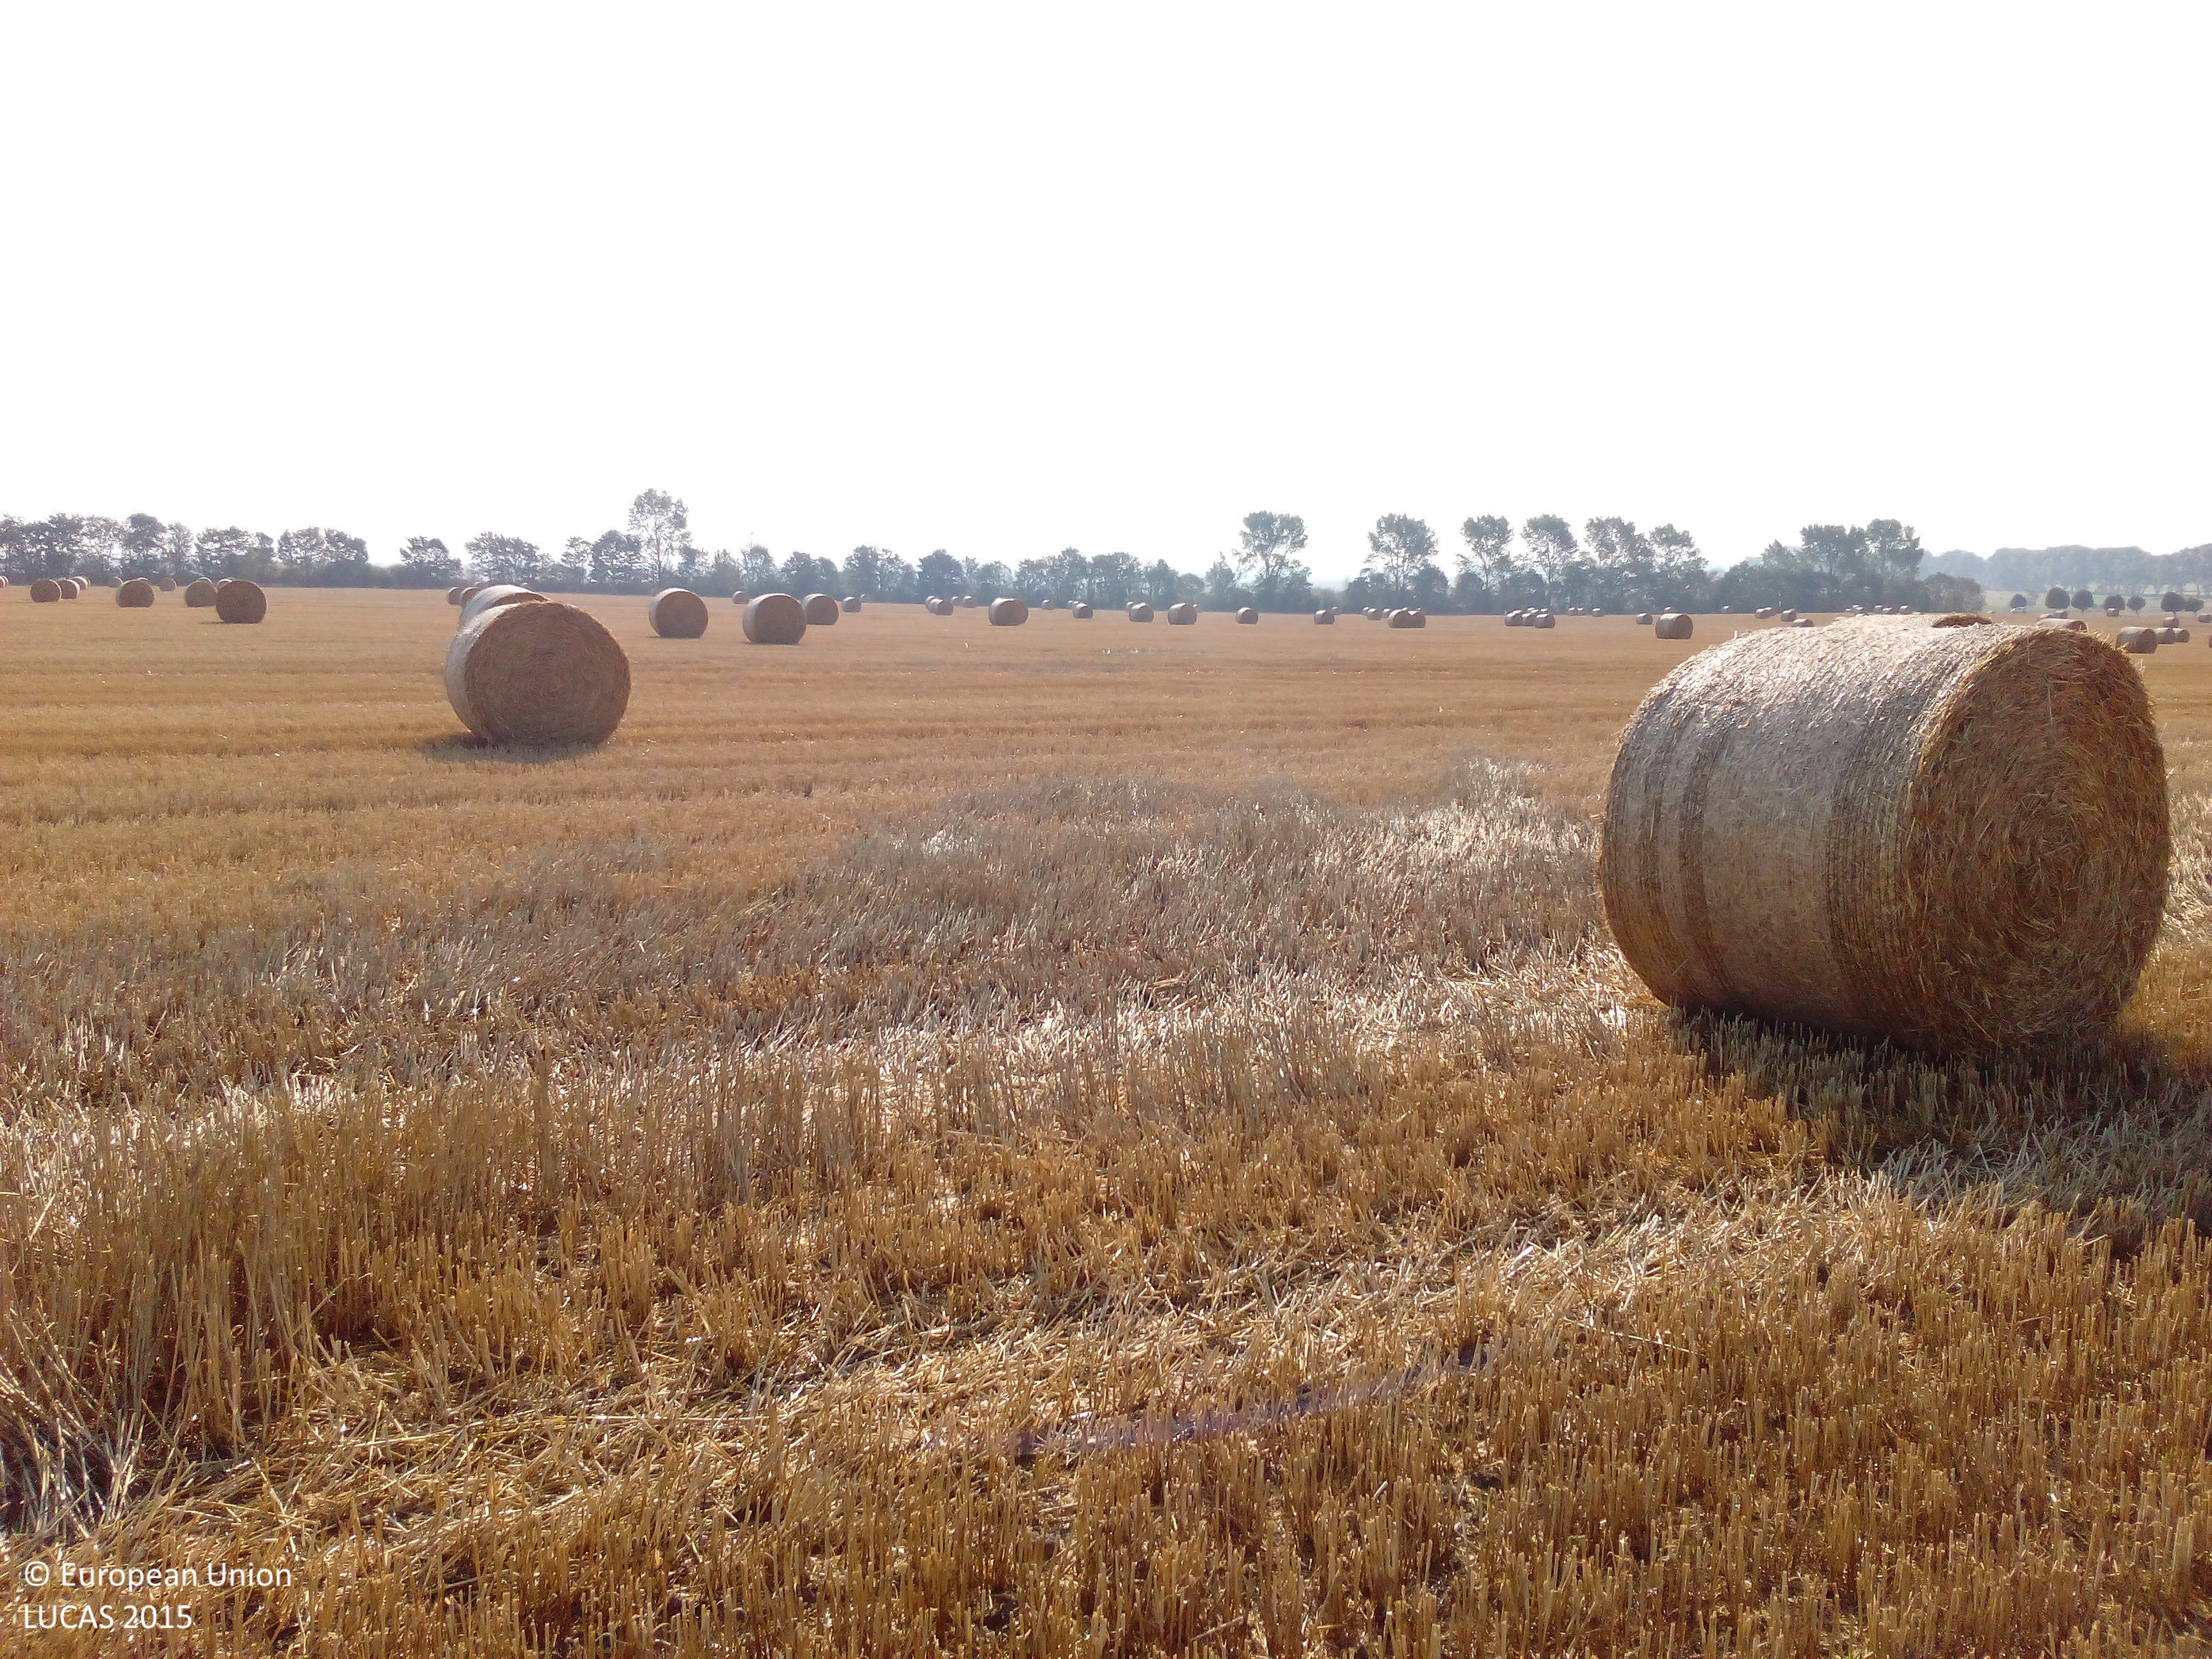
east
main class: Cropland
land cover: Common wheat
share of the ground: > 75 %
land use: Agriculture (excluding fallow land and kitchen gardens)
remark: Harvested field
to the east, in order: Common wheat
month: August
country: DE
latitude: 52.0486
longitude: 11.1224
